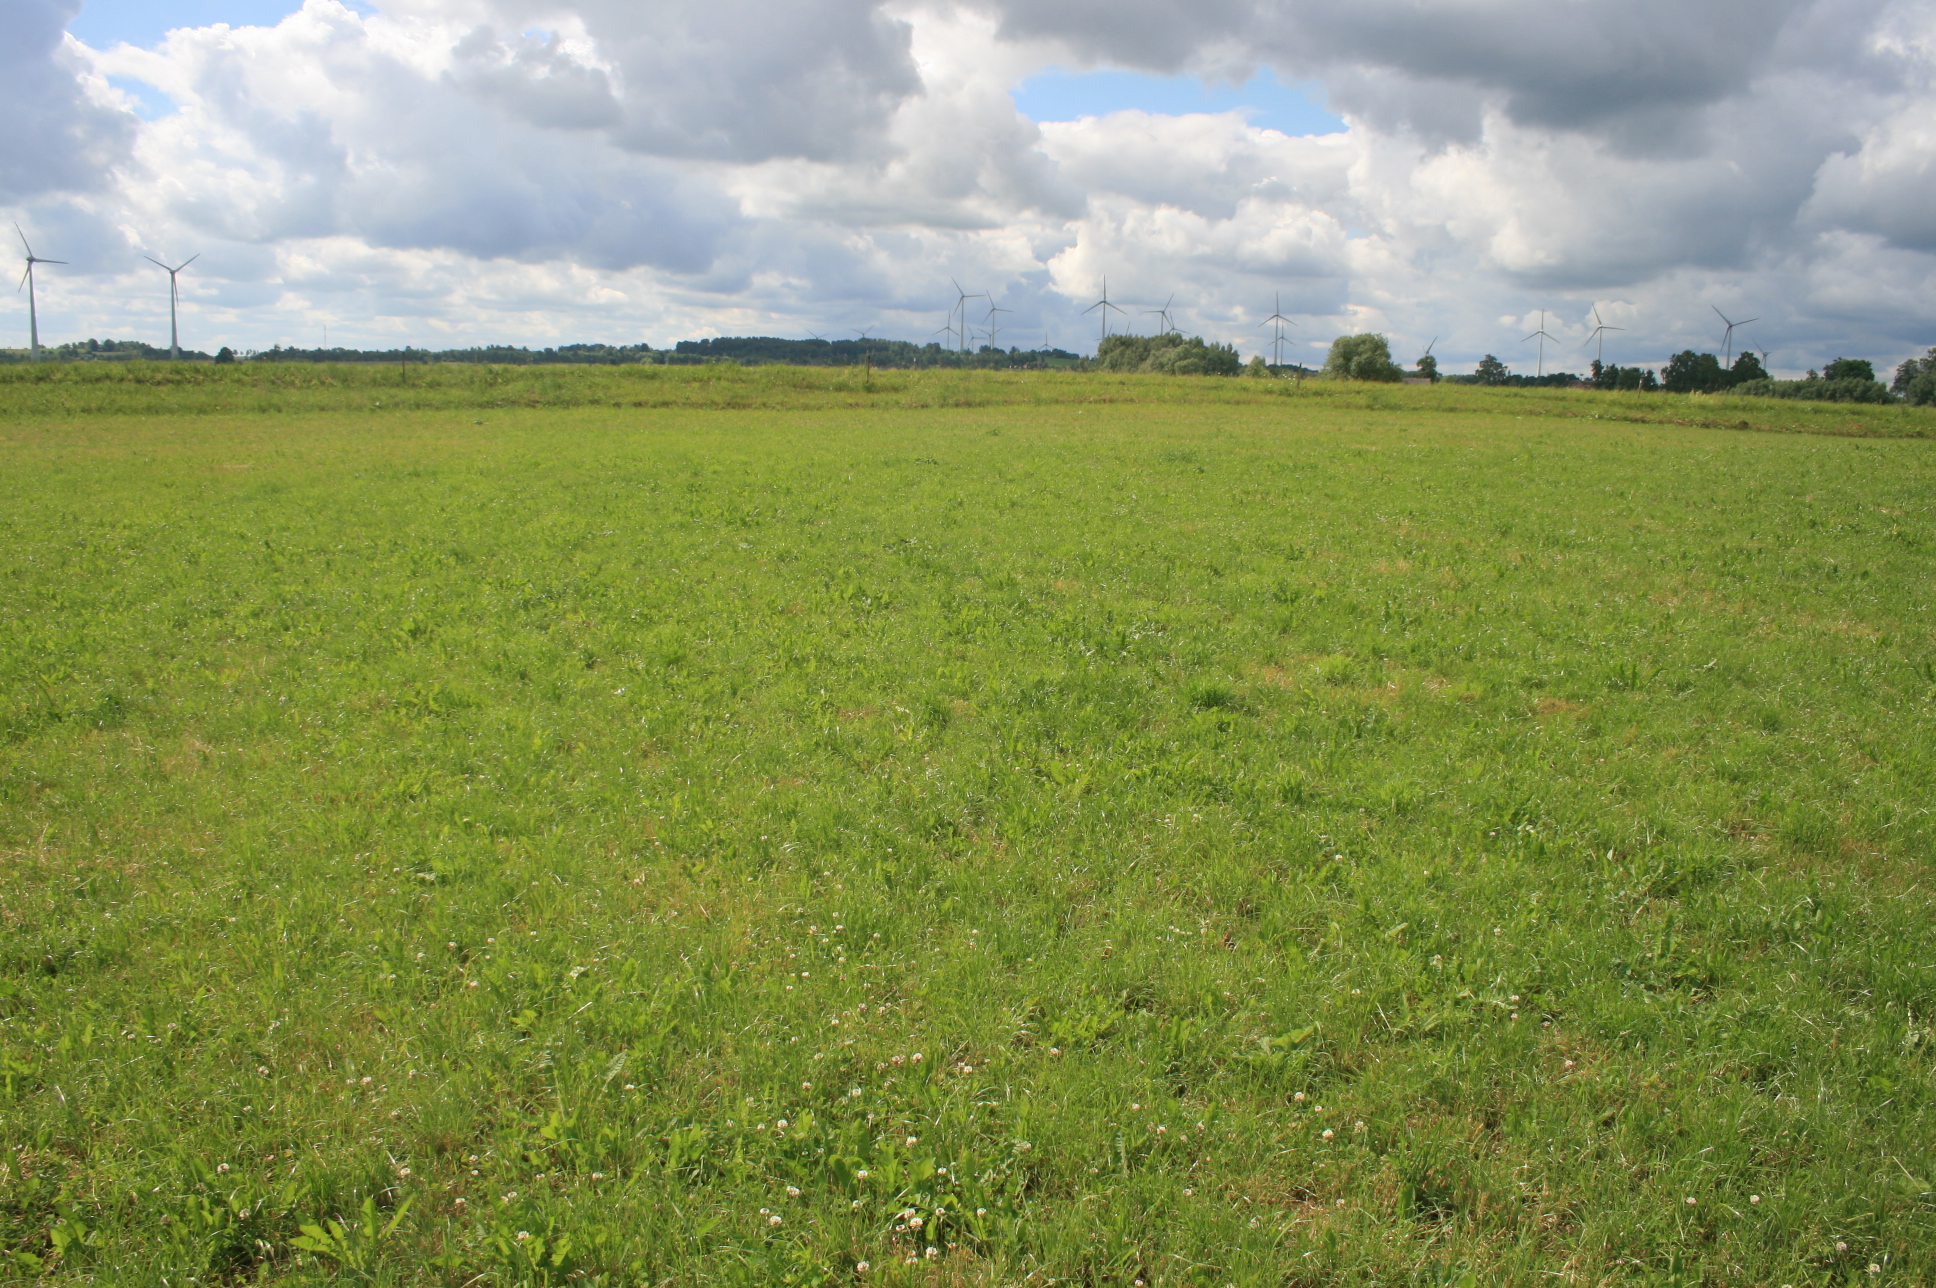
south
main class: Grassland
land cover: Grassland without tree/shrub cover
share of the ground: > 75 %
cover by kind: herbaceous plants 100 %
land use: Agriculture (excluding fallow land and kitchen gardens)
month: June
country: LT
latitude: 55.2143
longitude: 22.0786
